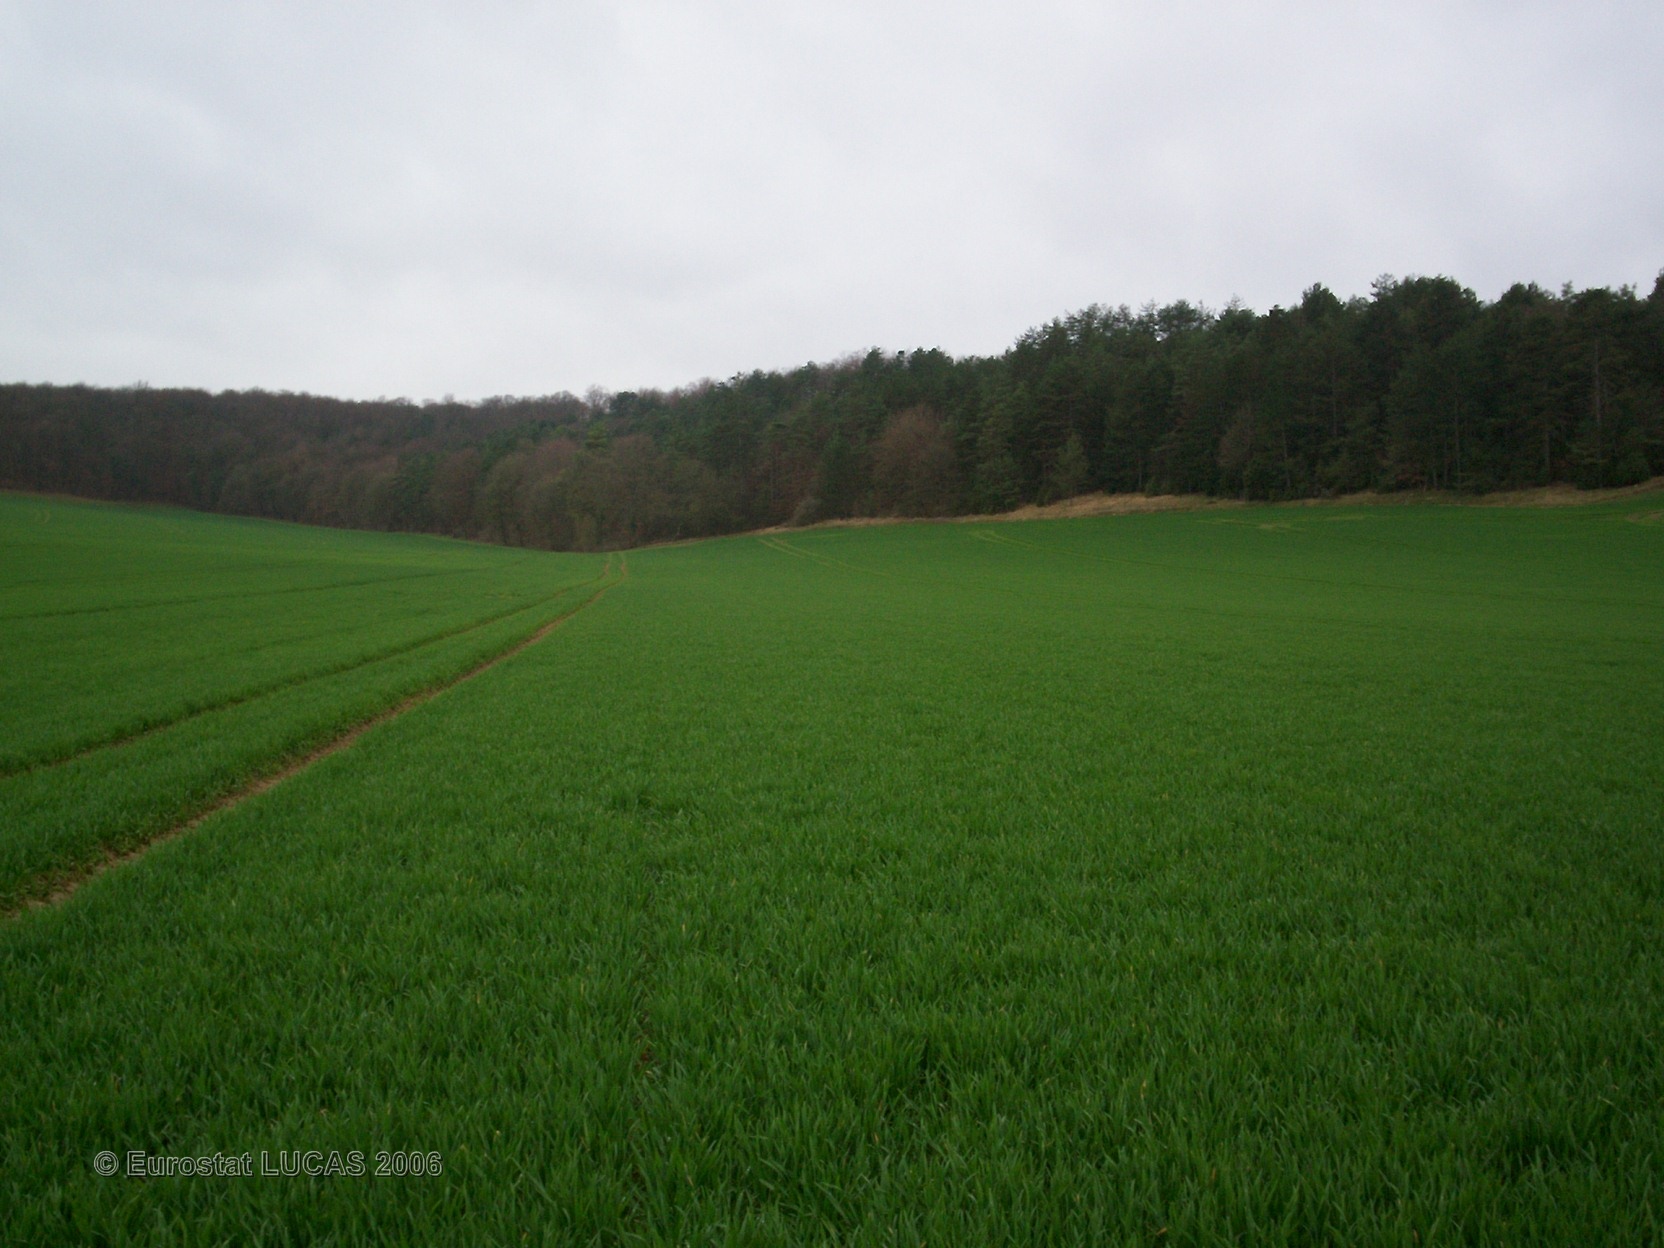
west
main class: Cropland
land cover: Common wheat
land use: Agriculture (excluding fallow land and kitchen gardens)
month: April
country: FR
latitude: 48.1264
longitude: 4.9606
